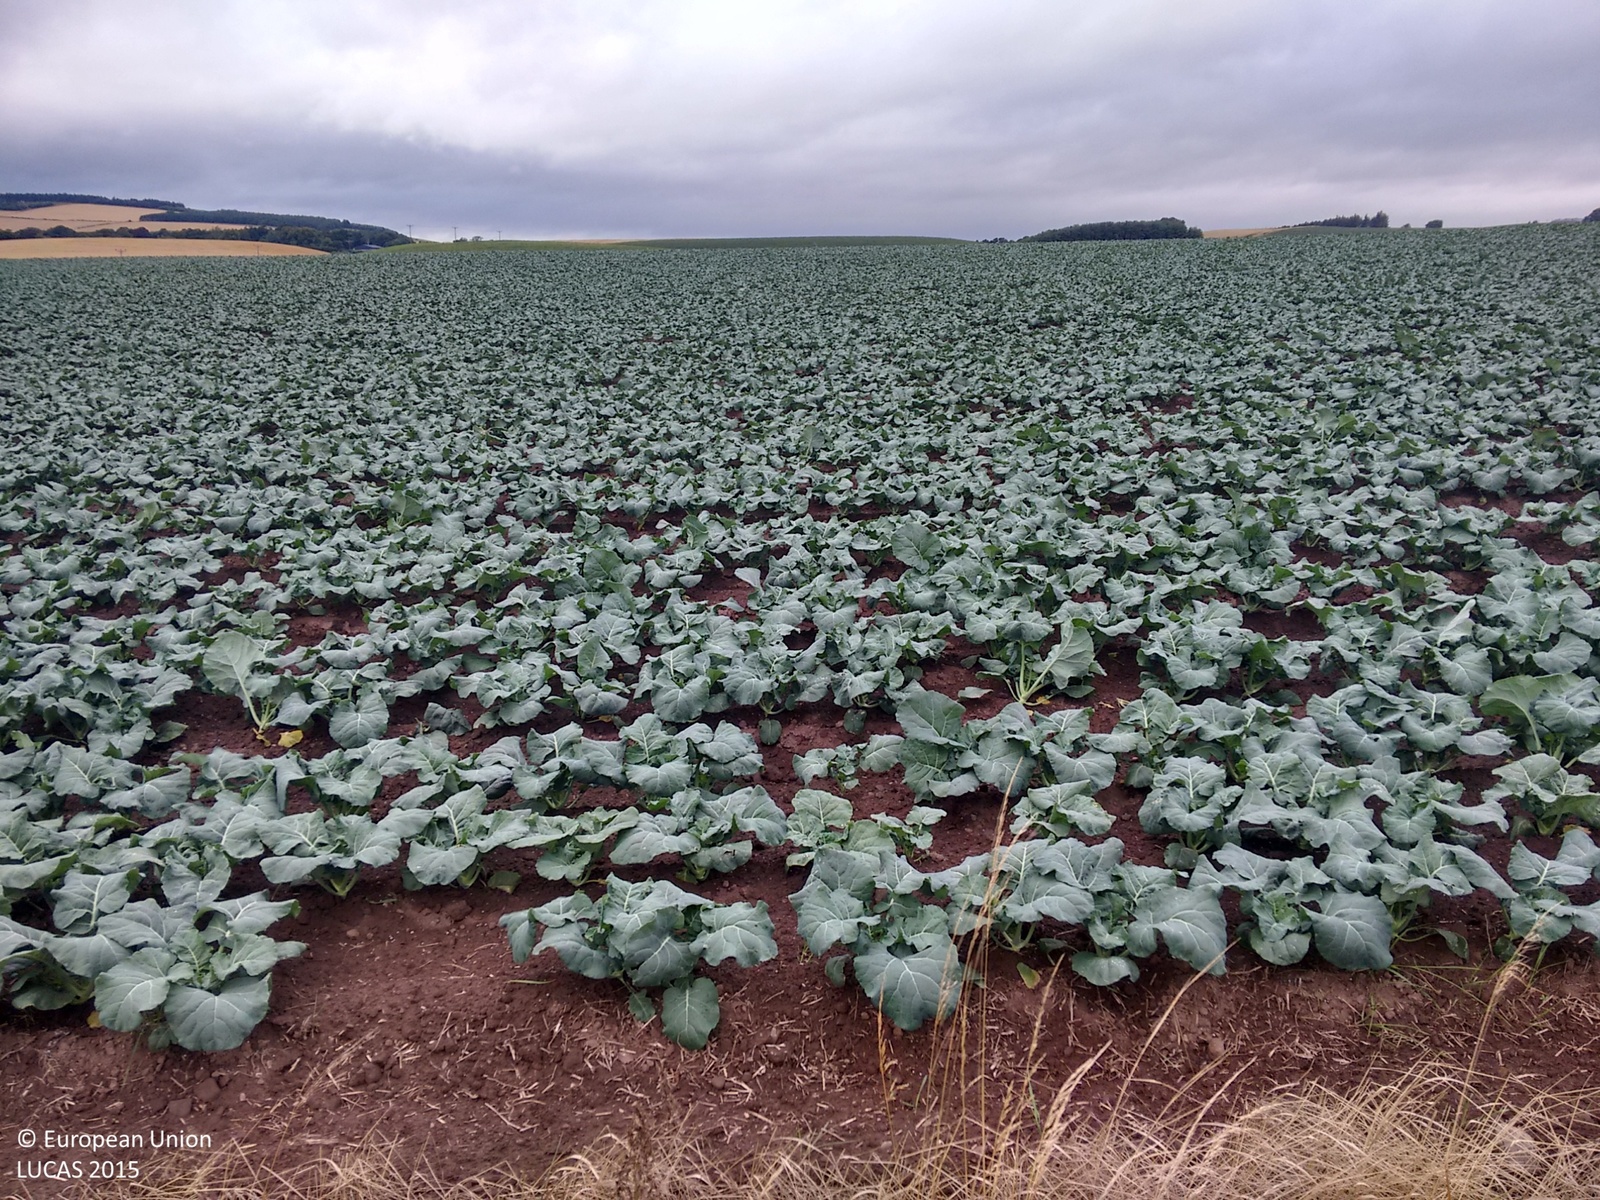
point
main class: Cropland
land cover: Other fresh vegetables
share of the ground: > 75 %
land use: Agriculture (excluding fallow land and kitchen gardens)
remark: Tilled/Sowed
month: August
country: GB
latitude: 55.5287
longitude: -2.4004
